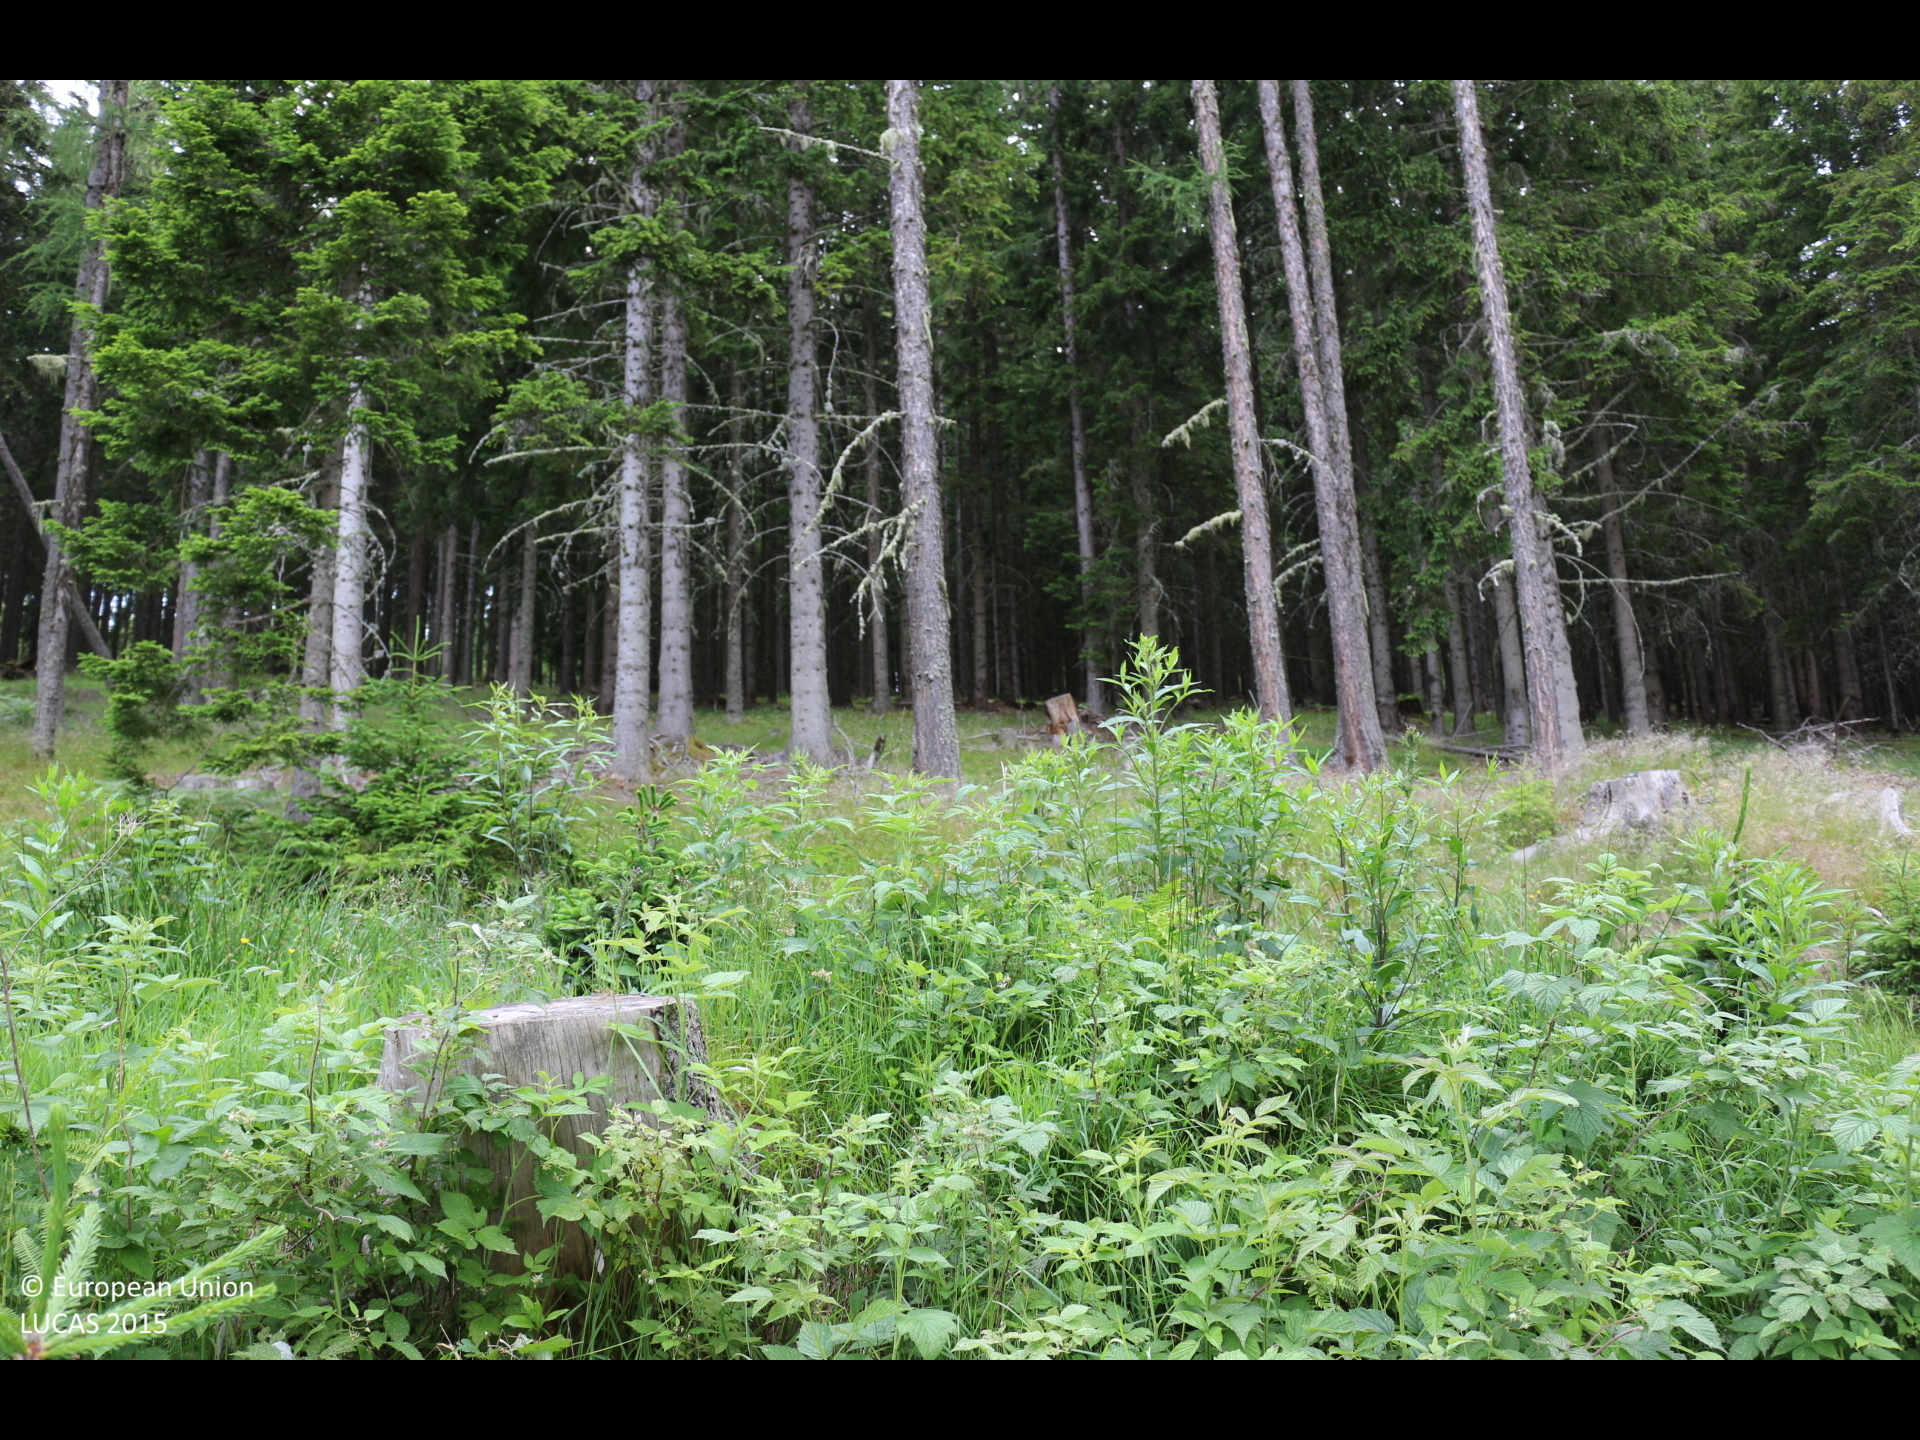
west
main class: Woodland
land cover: Other coniferous woodland
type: alpine coniferous forest
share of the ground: 25 - 50 %
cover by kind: herbaceous plants 60 %, coniferous forest trees 30 %, shrubs 10 %
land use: Forestry
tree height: > 5 m
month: June
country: AT
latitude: 46.9025
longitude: 14.1329
